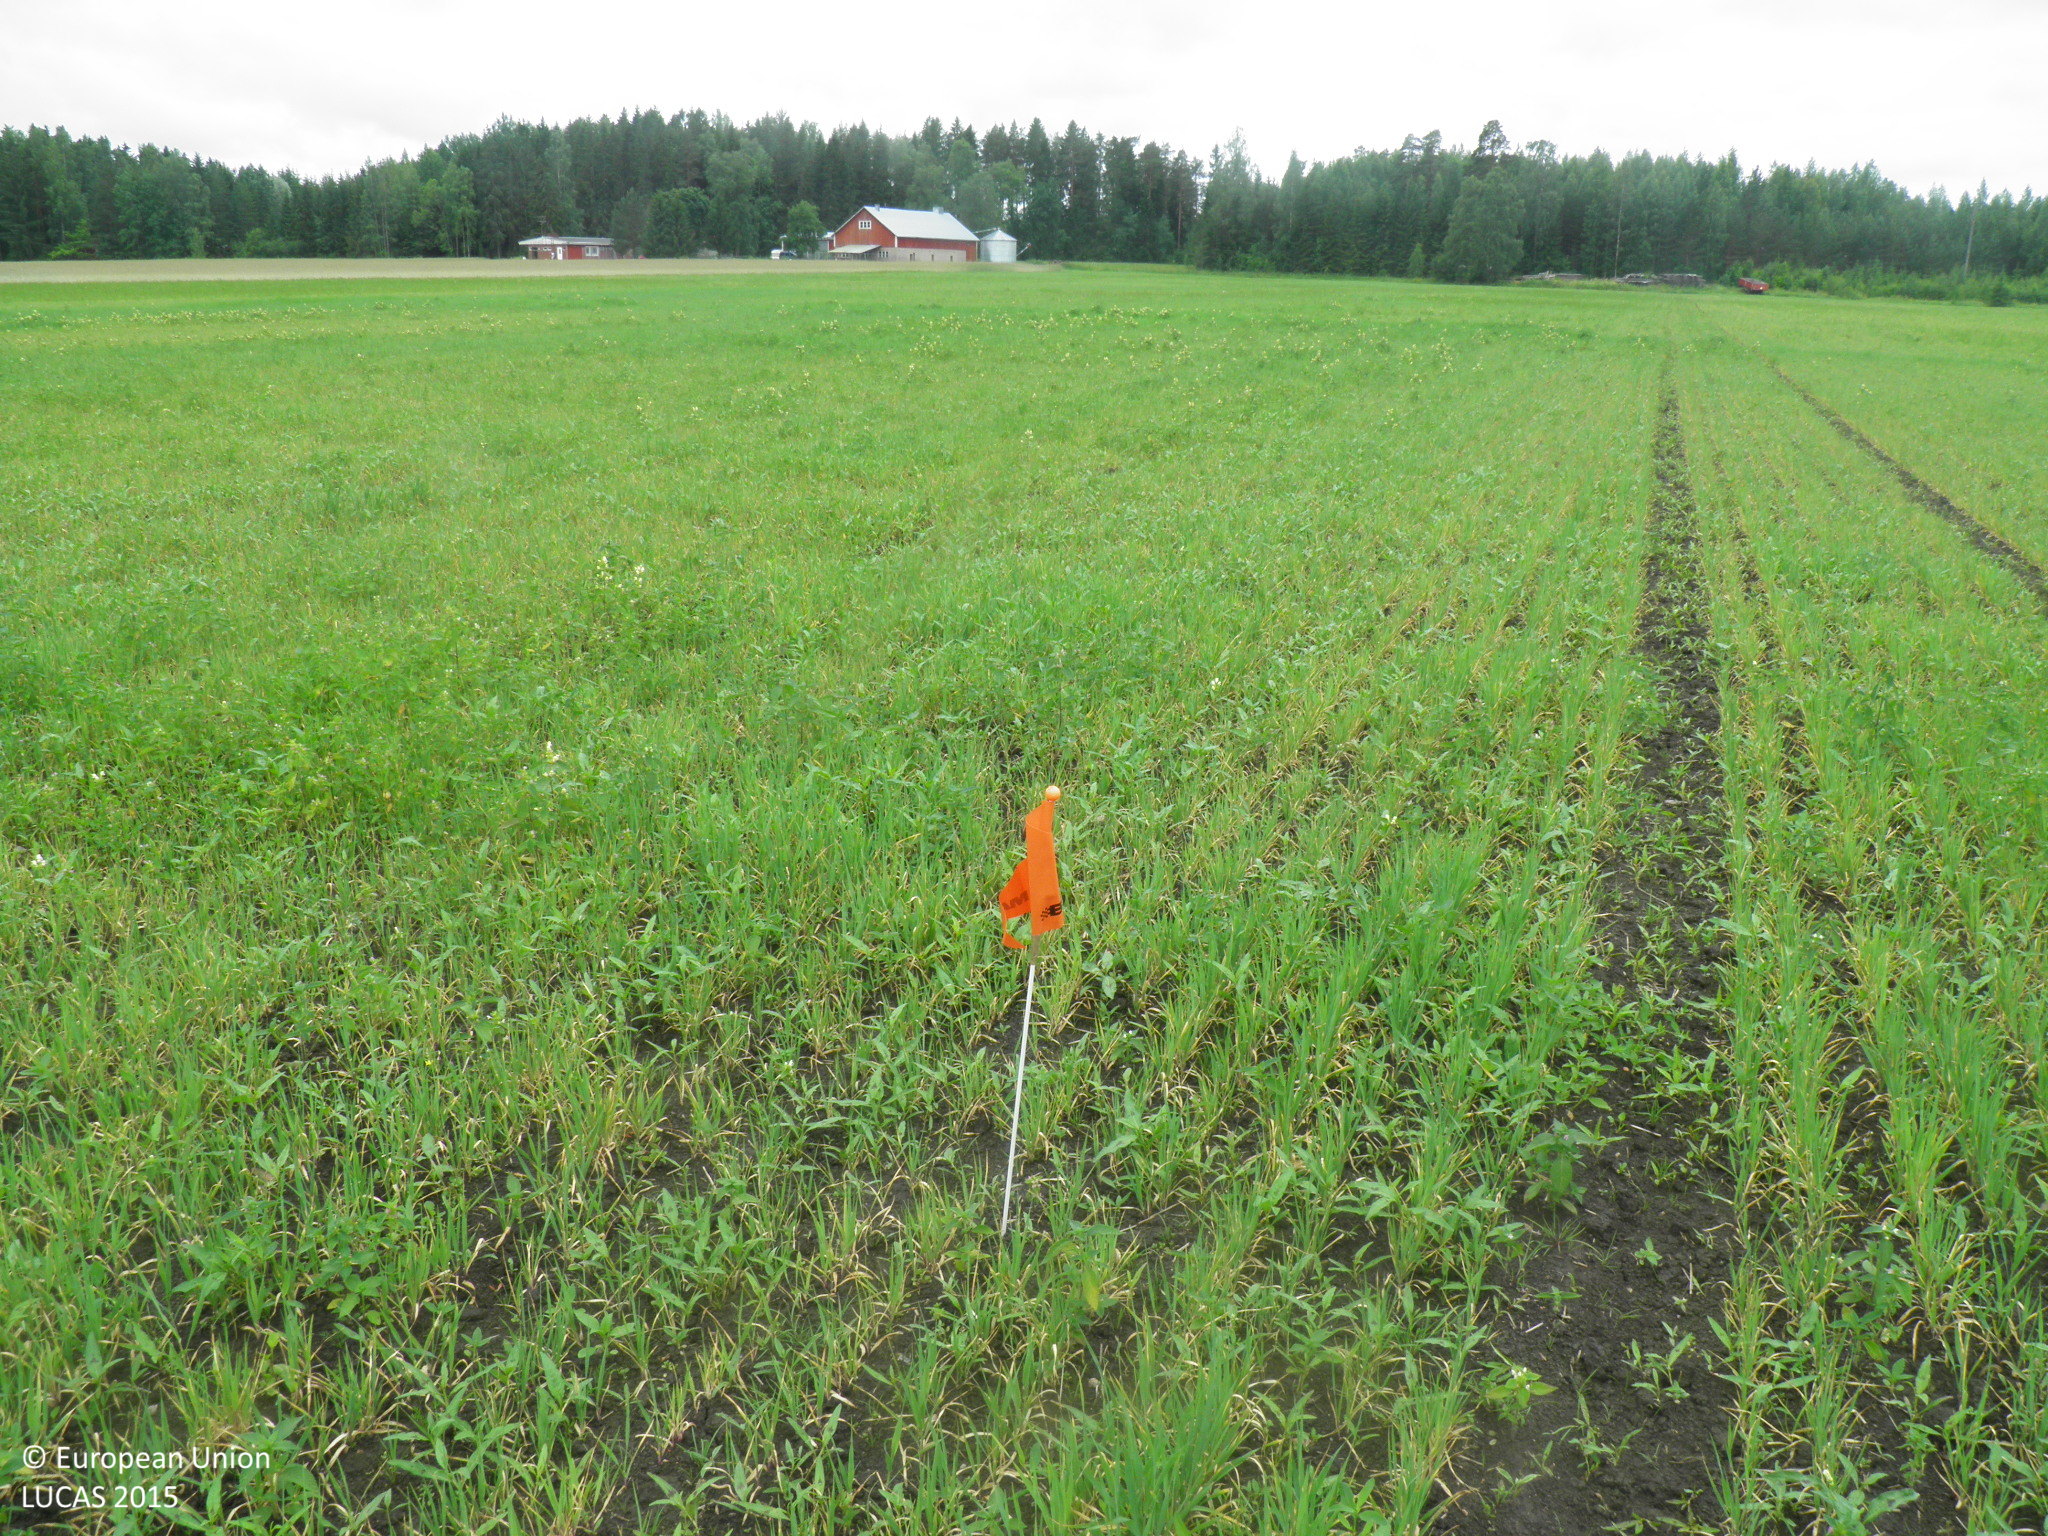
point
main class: Cropland
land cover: Barley
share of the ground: > 75 %
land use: Agriculture (excluding fallow land and kitchen gardens)
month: July
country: FI
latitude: 60.6621
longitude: 22.7156
